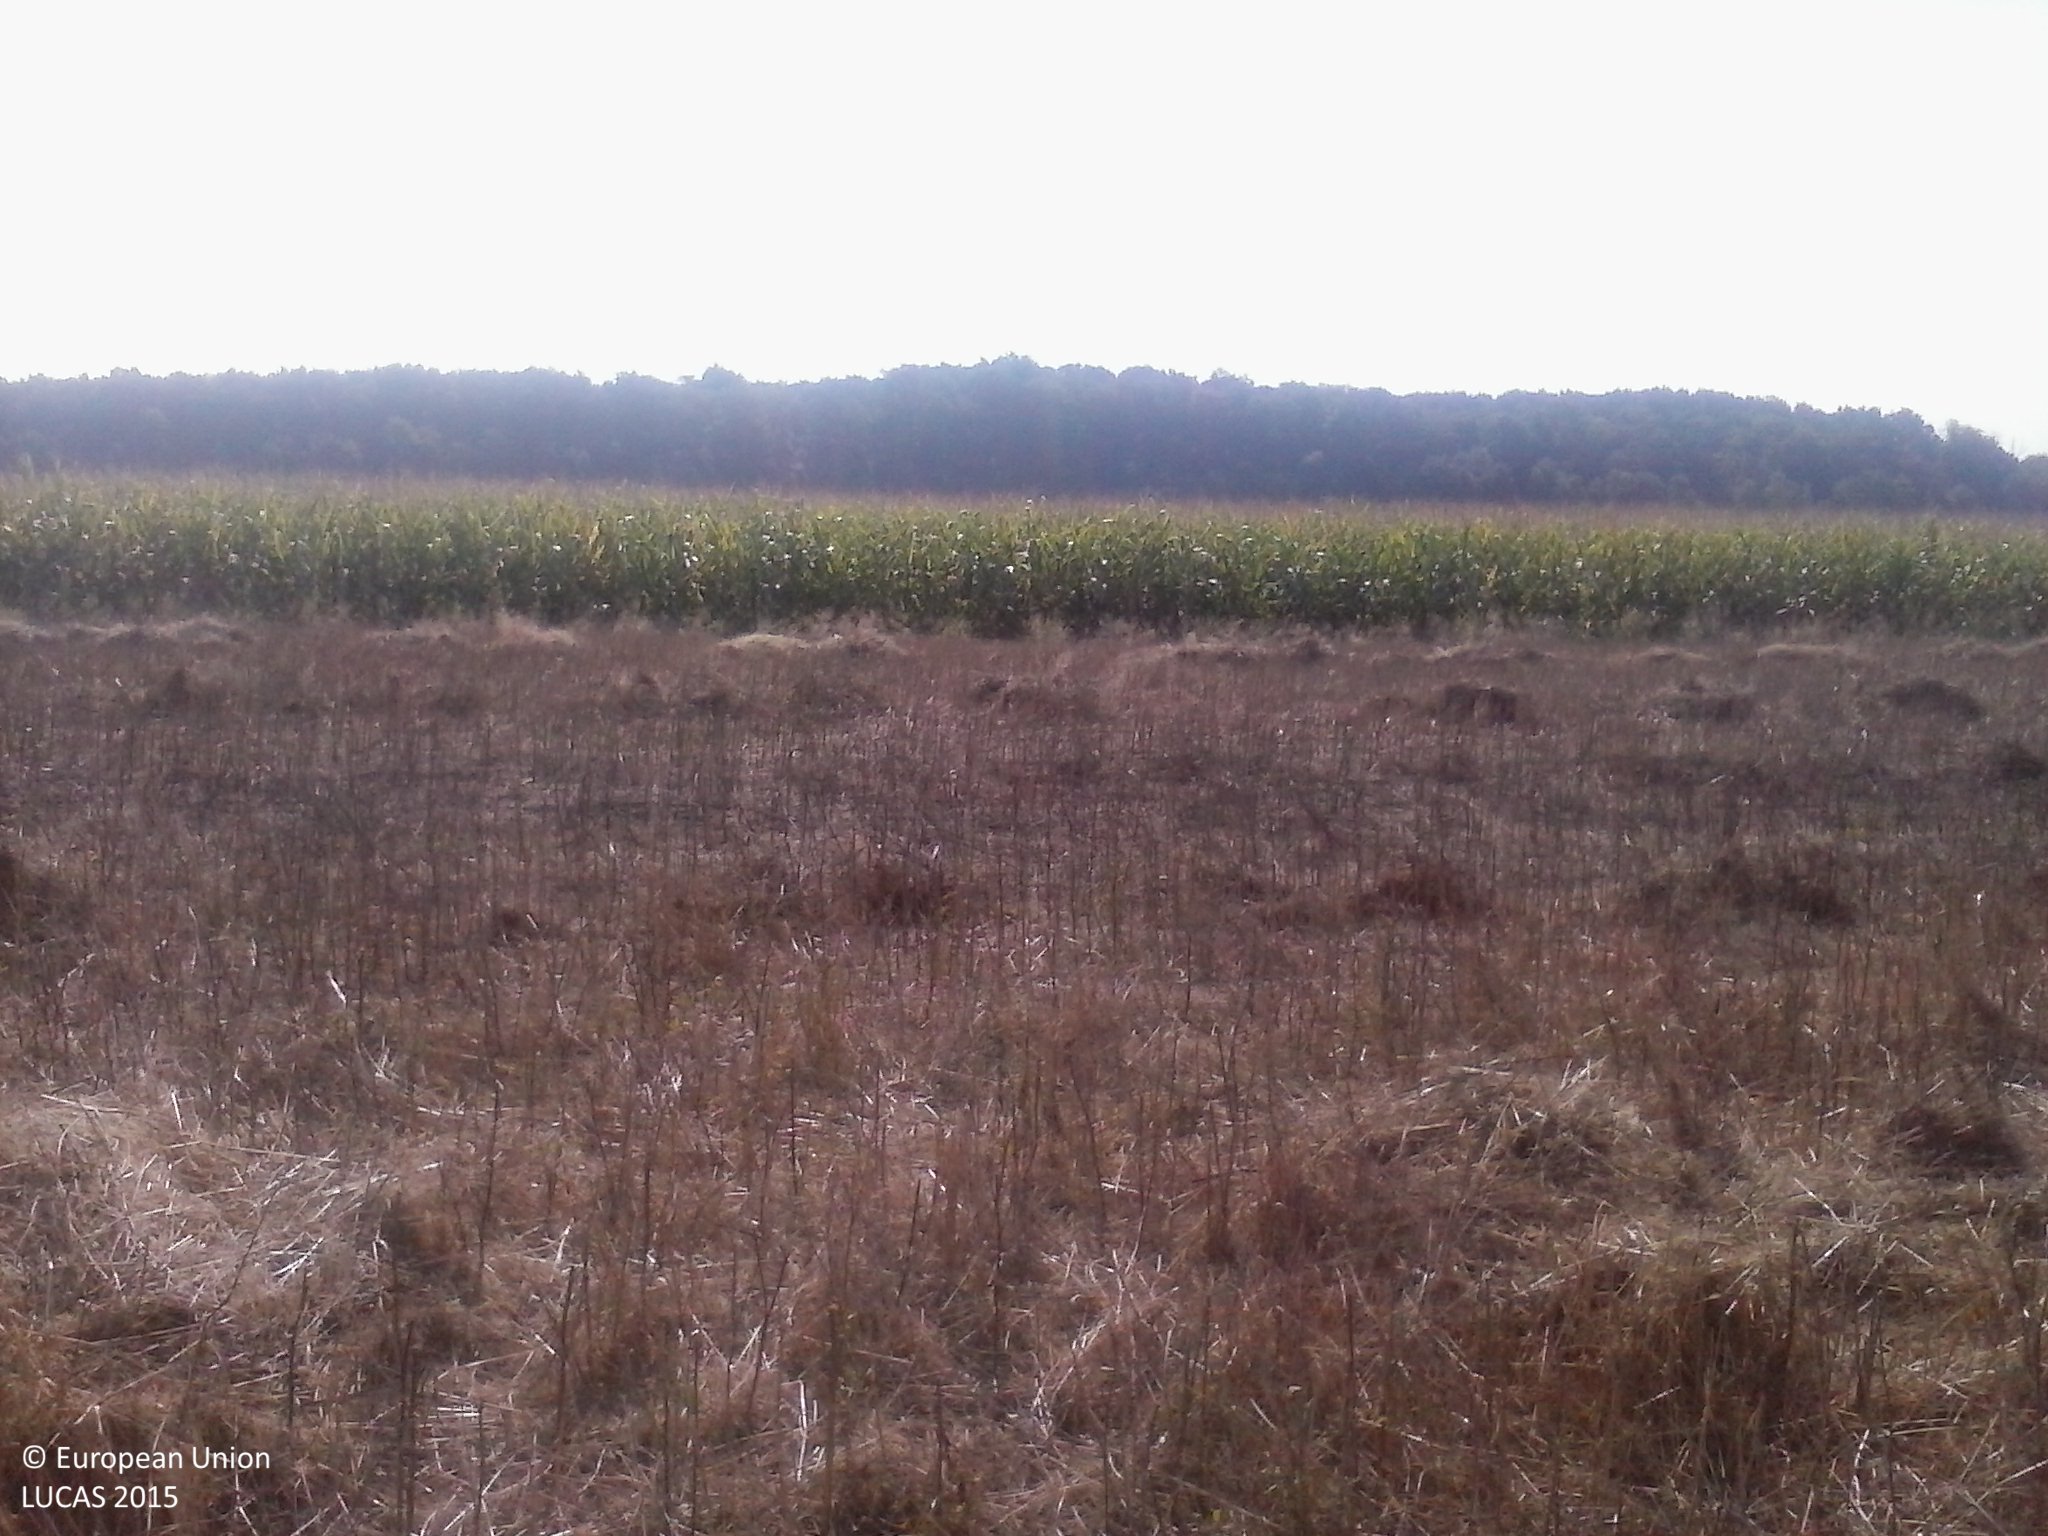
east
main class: Cropland
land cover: Rape and turnip rape
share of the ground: 25 - 50 %
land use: Agriculture (excluding fallow land and kitchen gardens)
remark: Harvested field
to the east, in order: Rape and turnip rape; Maize
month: August
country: HU
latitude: 45.8916
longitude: 17.9565
